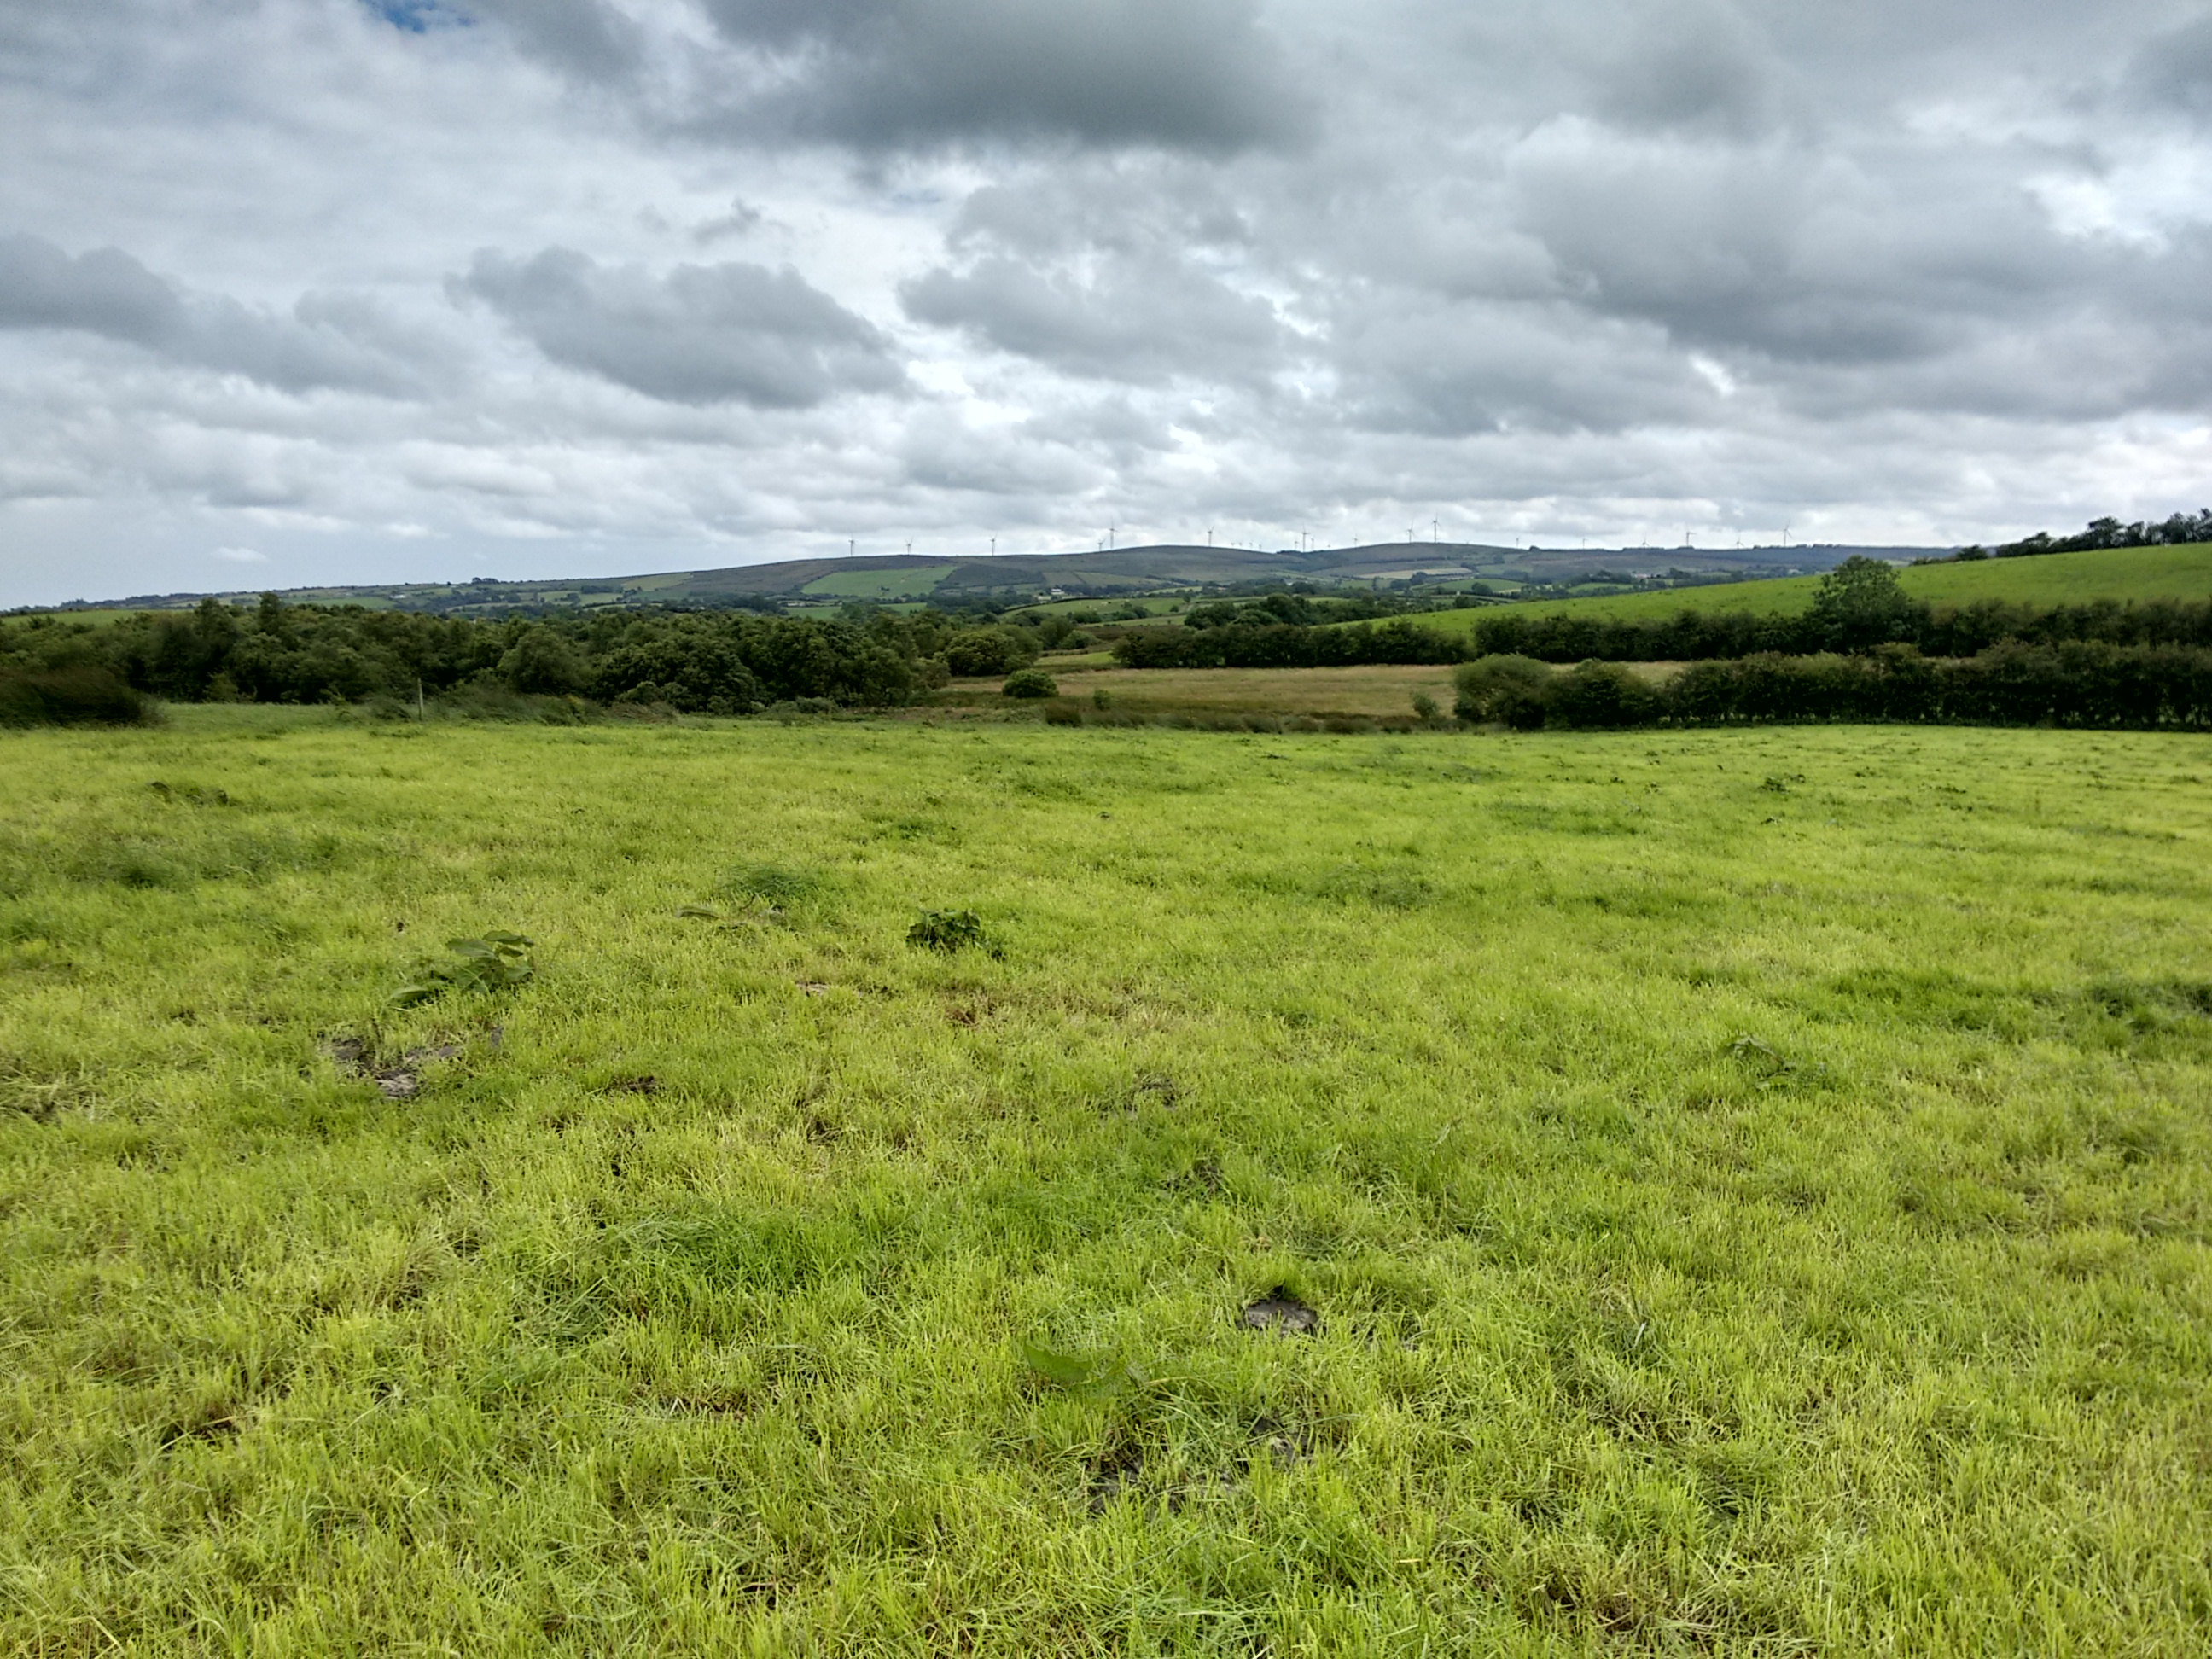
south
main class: Grassland
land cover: Grassland without tree/shrub cover
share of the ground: > 75 %
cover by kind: herbaceous plants 100 %
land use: Agriculture (excluding fallow land and kitchen gardens)
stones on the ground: < 10 %
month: July
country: GB
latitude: 54.4916
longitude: -7.3649
